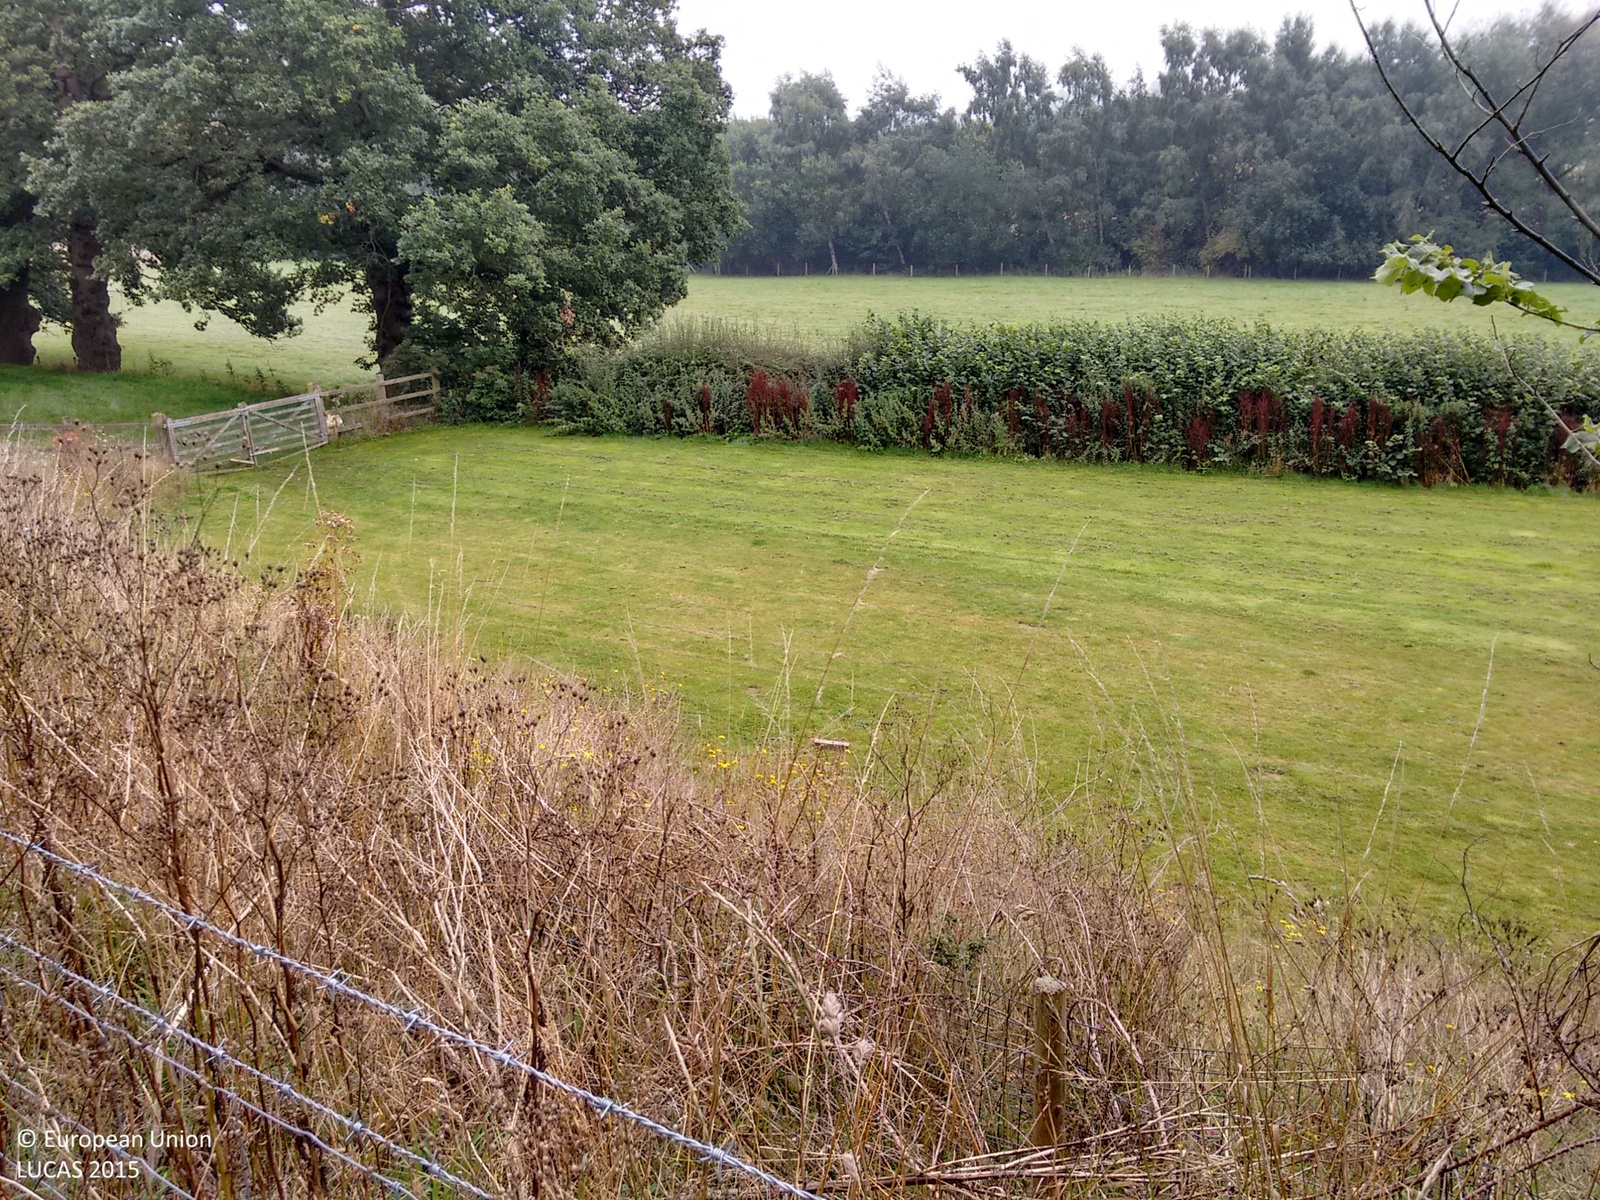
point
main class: Grassland
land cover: Grassland without tree/shrub cover
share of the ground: > 75 %
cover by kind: herbaceous plants 100 %
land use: Agriculture (excluding fallow land and kitchen gardens)
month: September
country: GB
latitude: 52.7990
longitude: -2.9025
